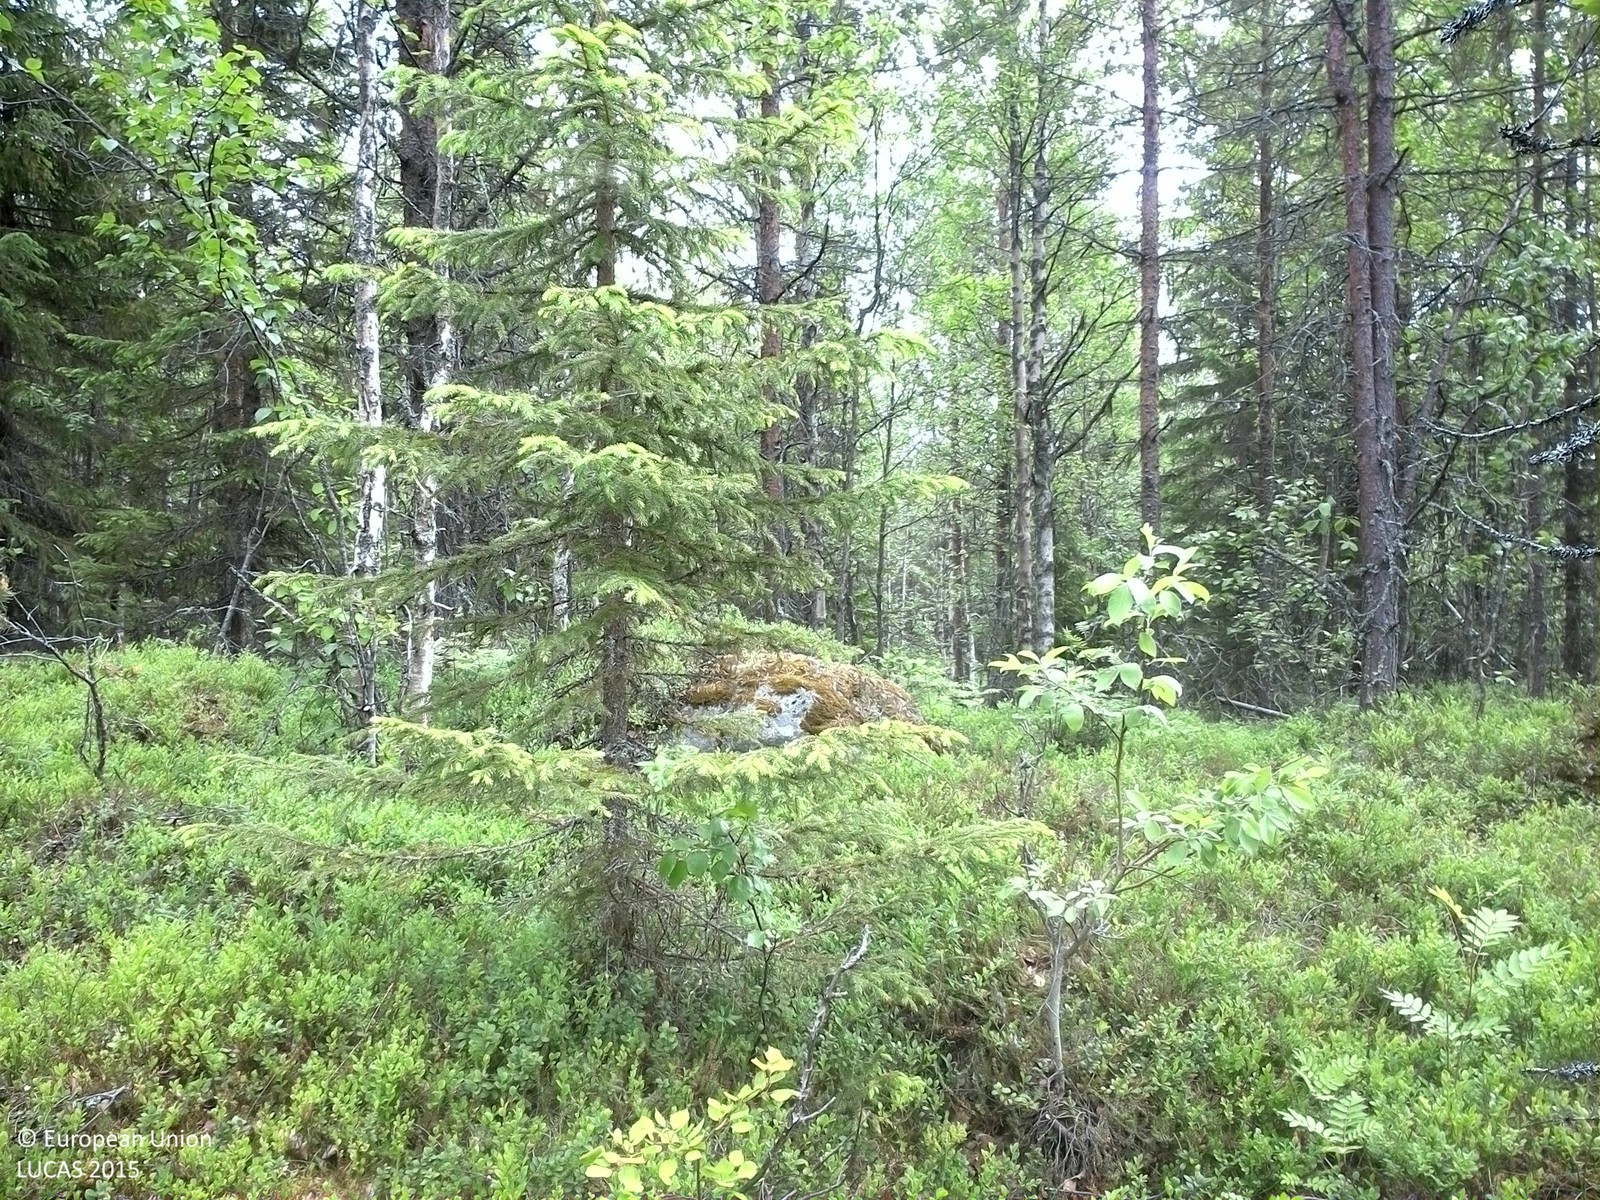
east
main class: Woodland
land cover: Spruce dominated mixed woodland
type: boreal forest
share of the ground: 50 - 75 %
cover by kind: coniferous forest trees 45 %, shrubs 30 %, broadleaved forest trees 15 %, lichens and mosses 10 %
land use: Forestry
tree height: > 5 m
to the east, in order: Spruce dominated mixed woodland; Rocks and stones; Ditches and canals; Paved roads, cycling and walking lanes; Ditches and canals; Rocks and stones; Spruce dominated mixed woodland
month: July
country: SE
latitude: 64.1251
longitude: 16.8089
